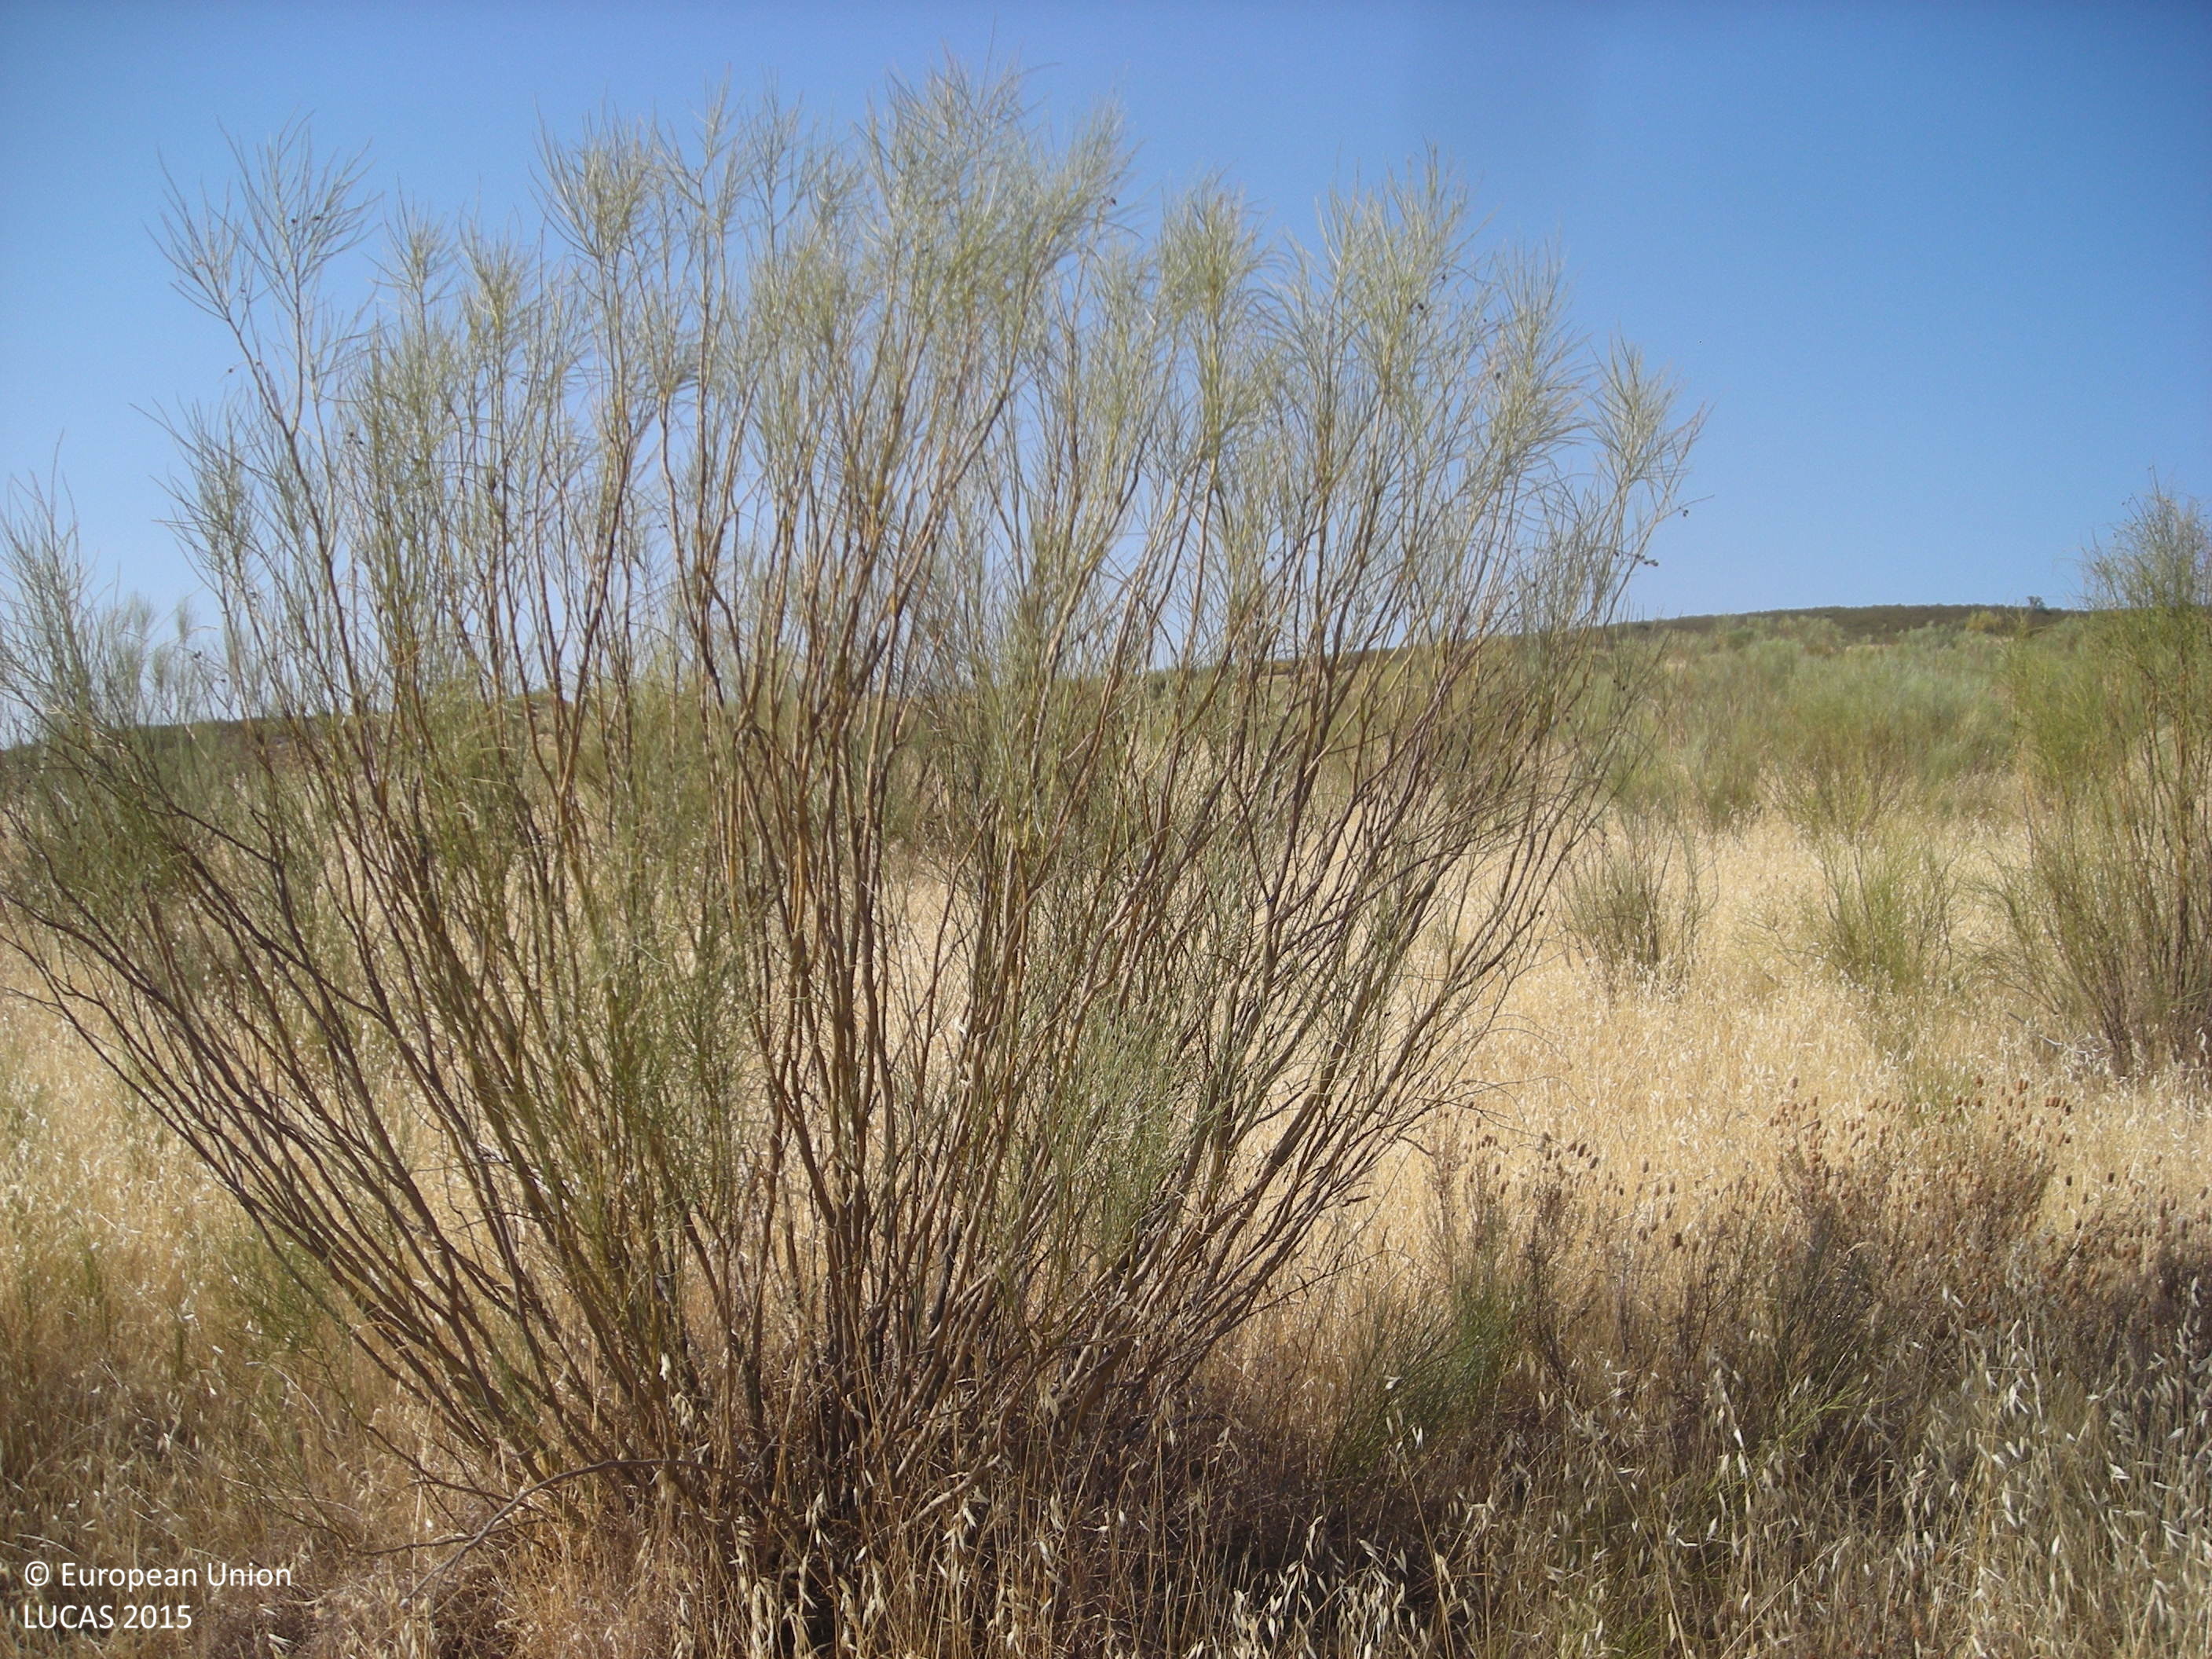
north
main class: Shrubland
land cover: Shrubland without tree cover
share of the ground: > 75 %
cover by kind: shrubs 100 %
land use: Agriculture (excluding fallow land and kitchen gardens)
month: July
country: ES
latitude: 38.6903
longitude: -5.7590
